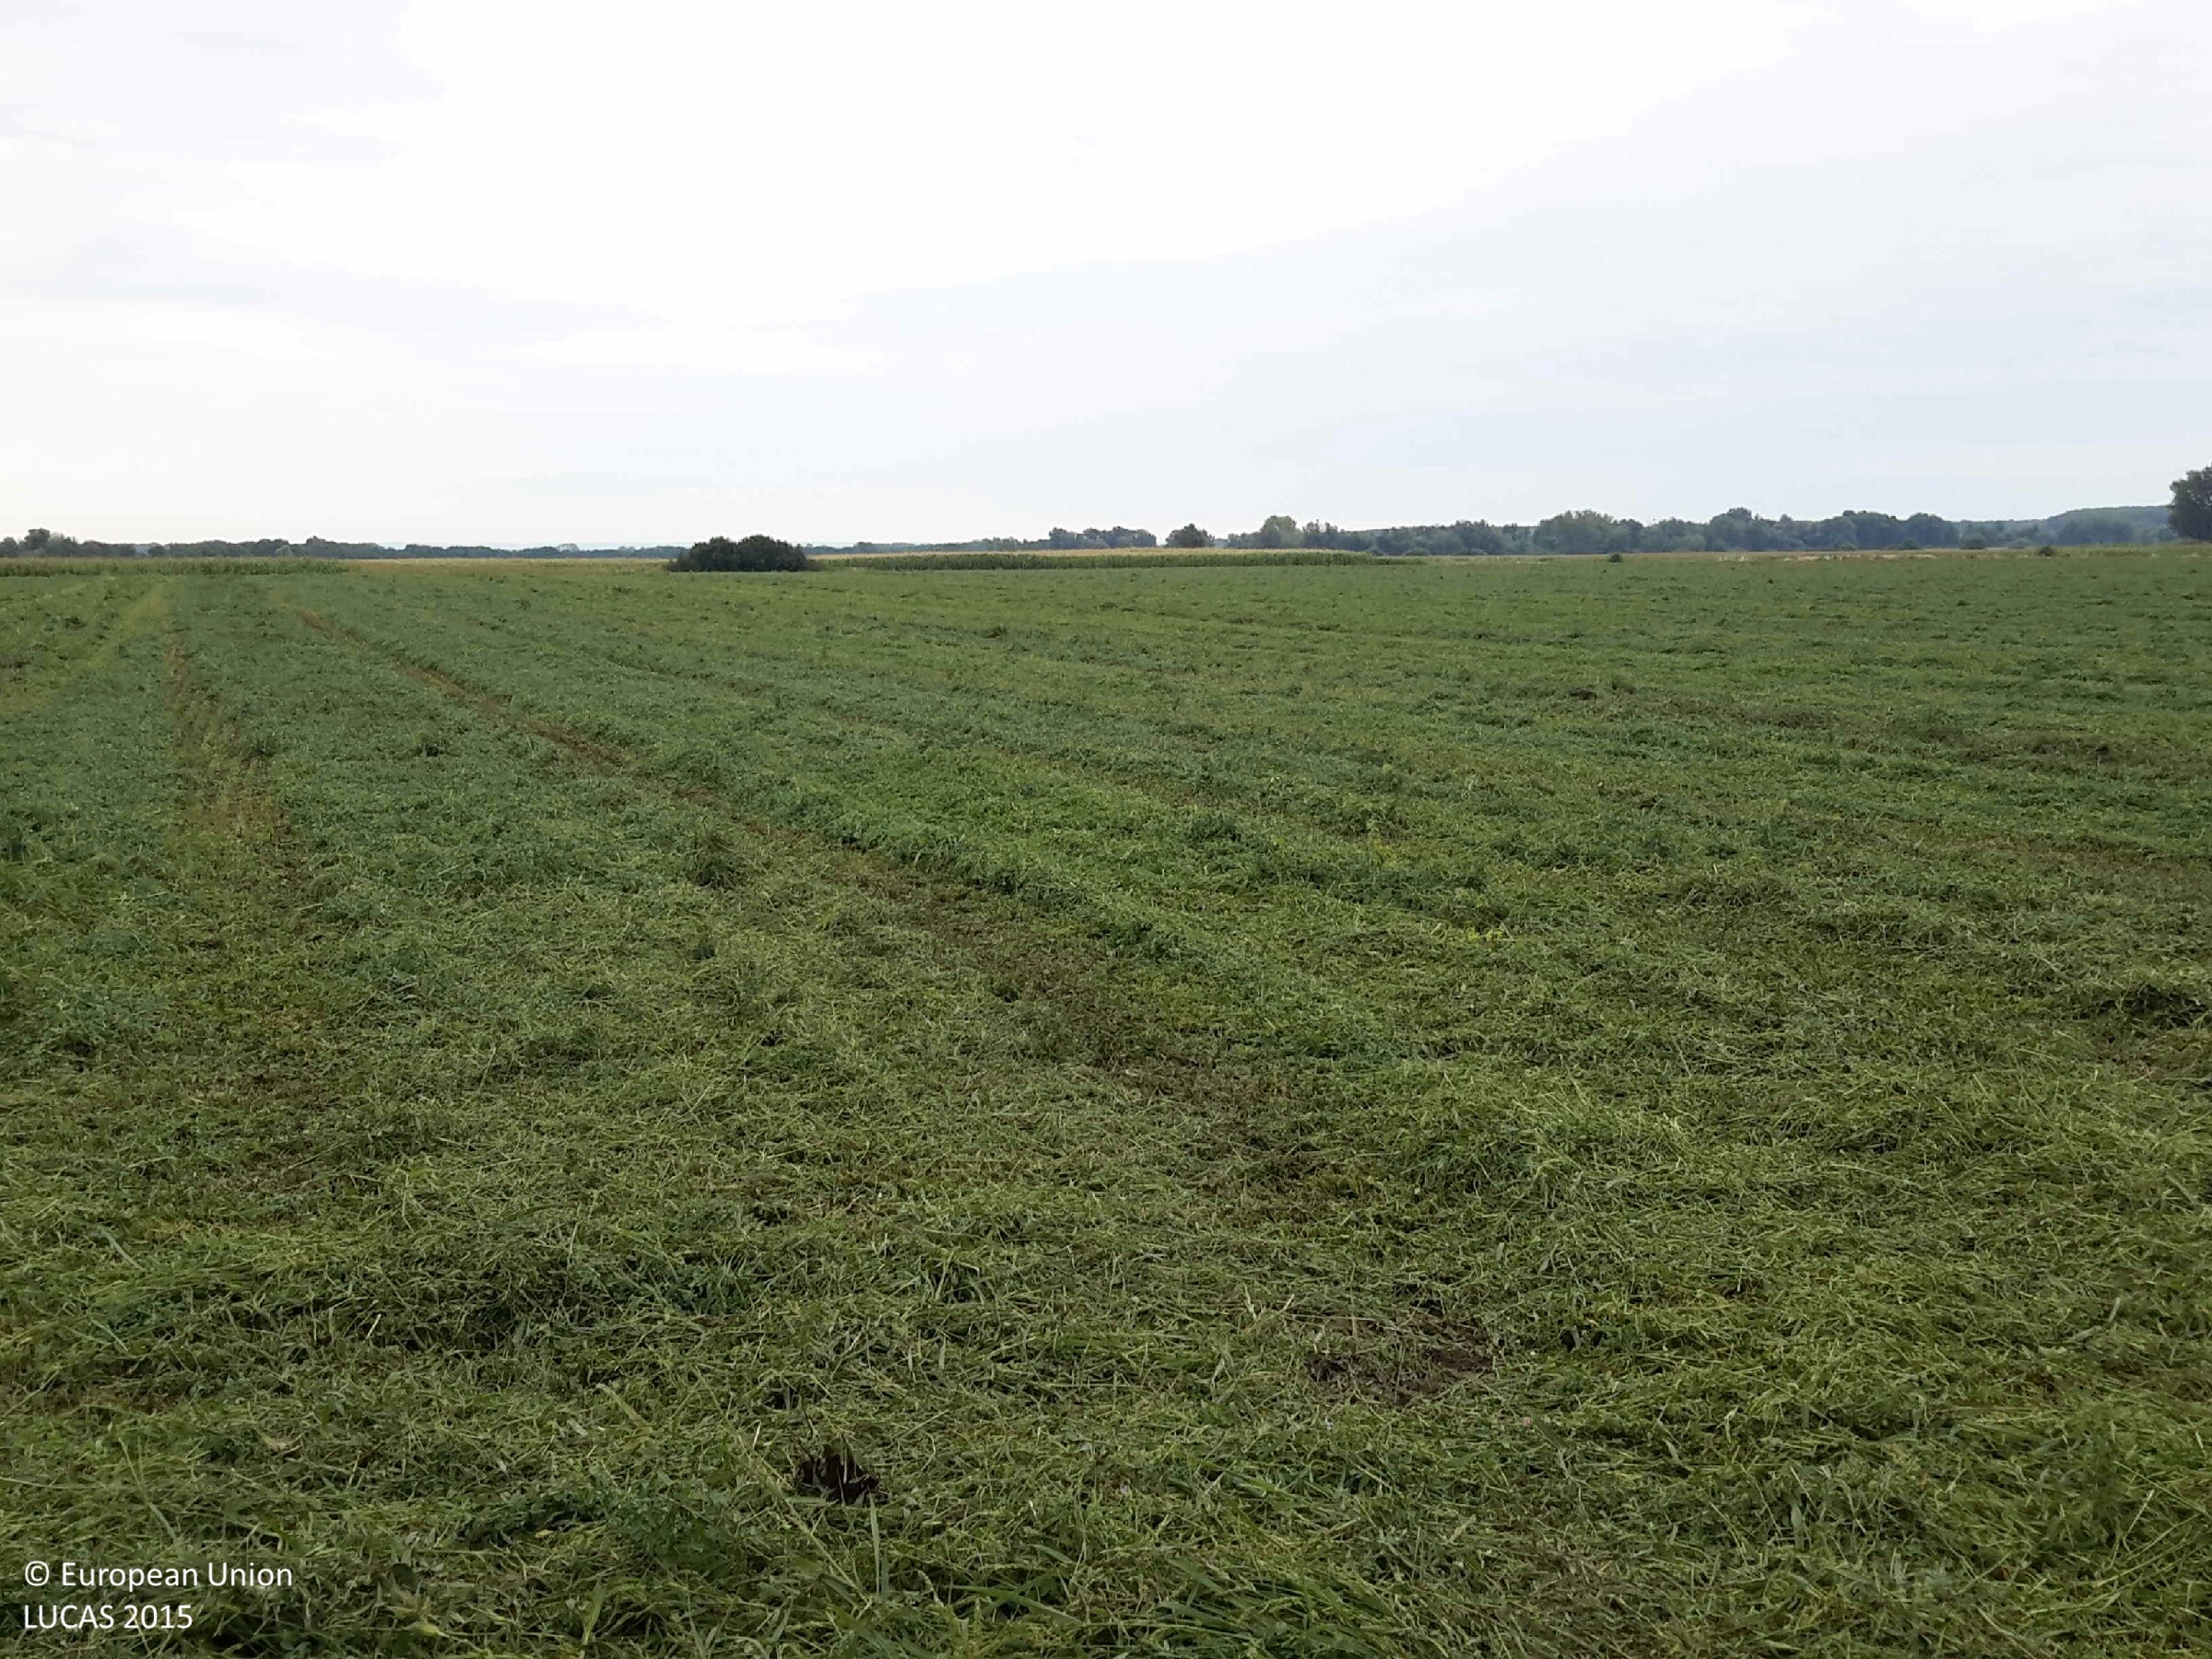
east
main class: Cropland
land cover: Lucerne
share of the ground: > 75 %
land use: Agriculture (excluding fallow land and kitchen gardens)
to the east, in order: Lucerne
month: July
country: HU
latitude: 47.5082
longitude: 17.3497
